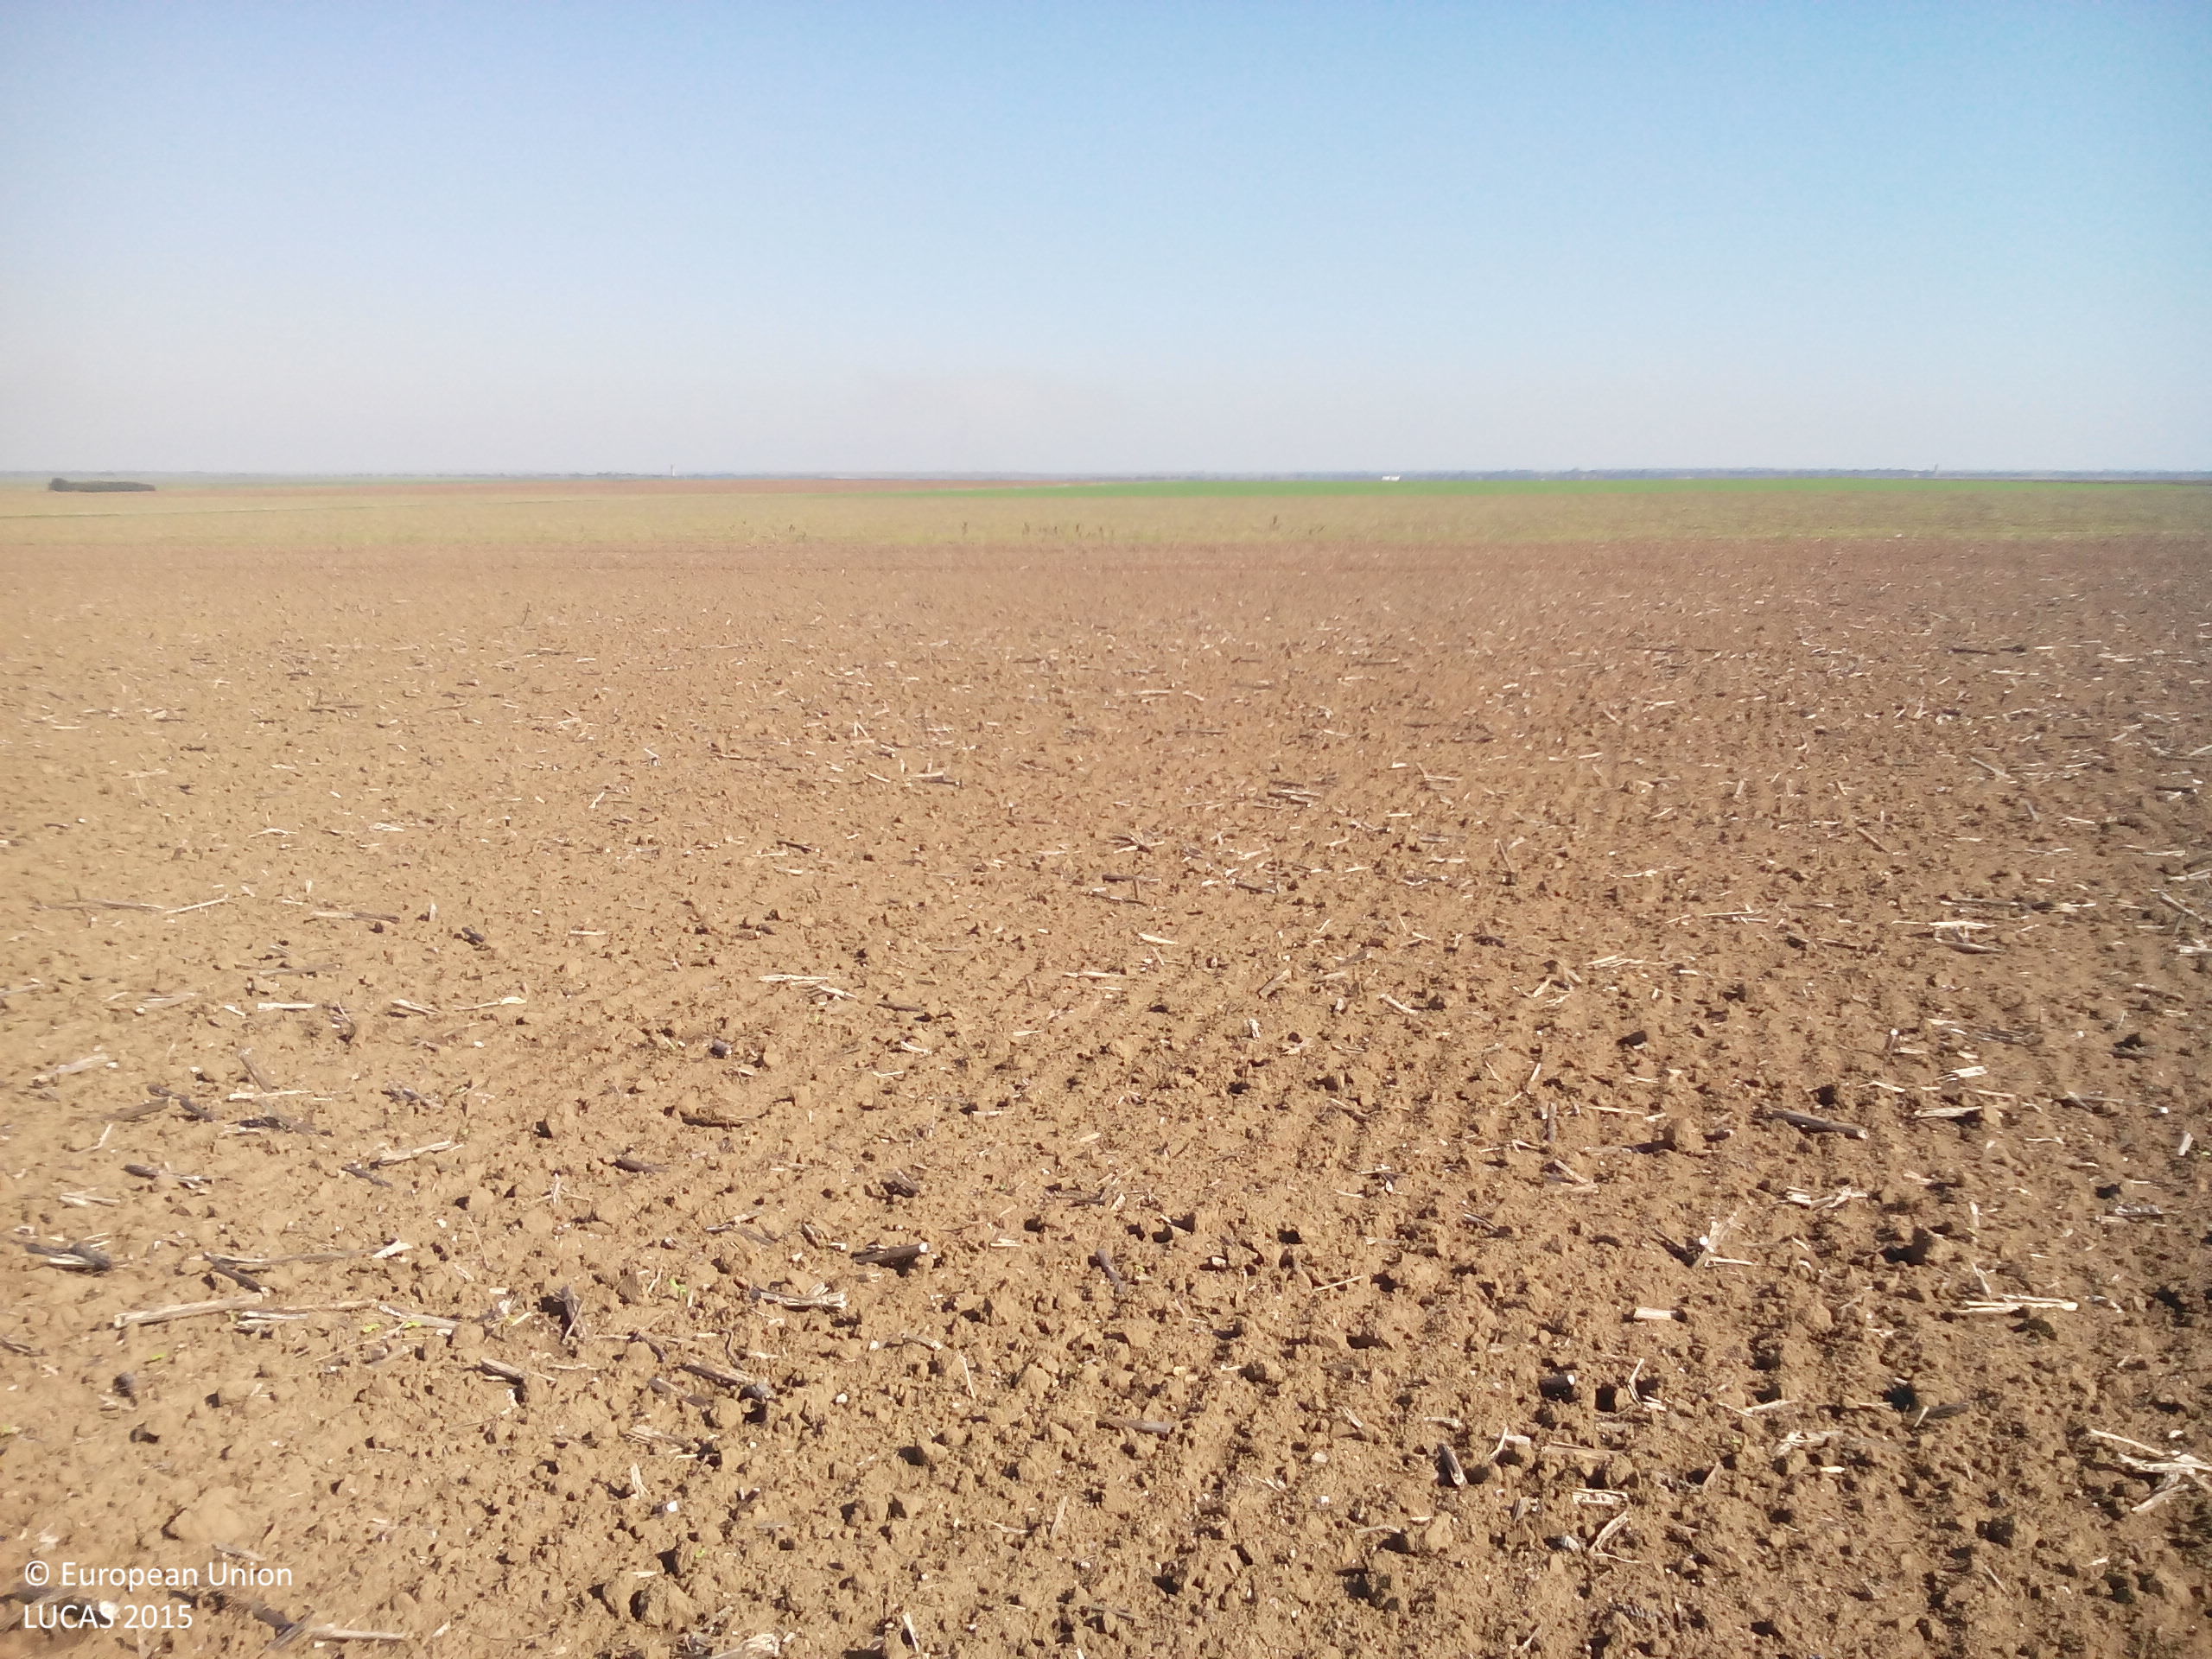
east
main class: Cropland
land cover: Sunflower
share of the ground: < 10 %
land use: Agriculture (excluding fallow land and kitchen gardens)
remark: Harvested field
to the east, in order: Sunflower; Common wheat
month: October
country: BG
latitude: 43.5354
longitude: 23.6471
